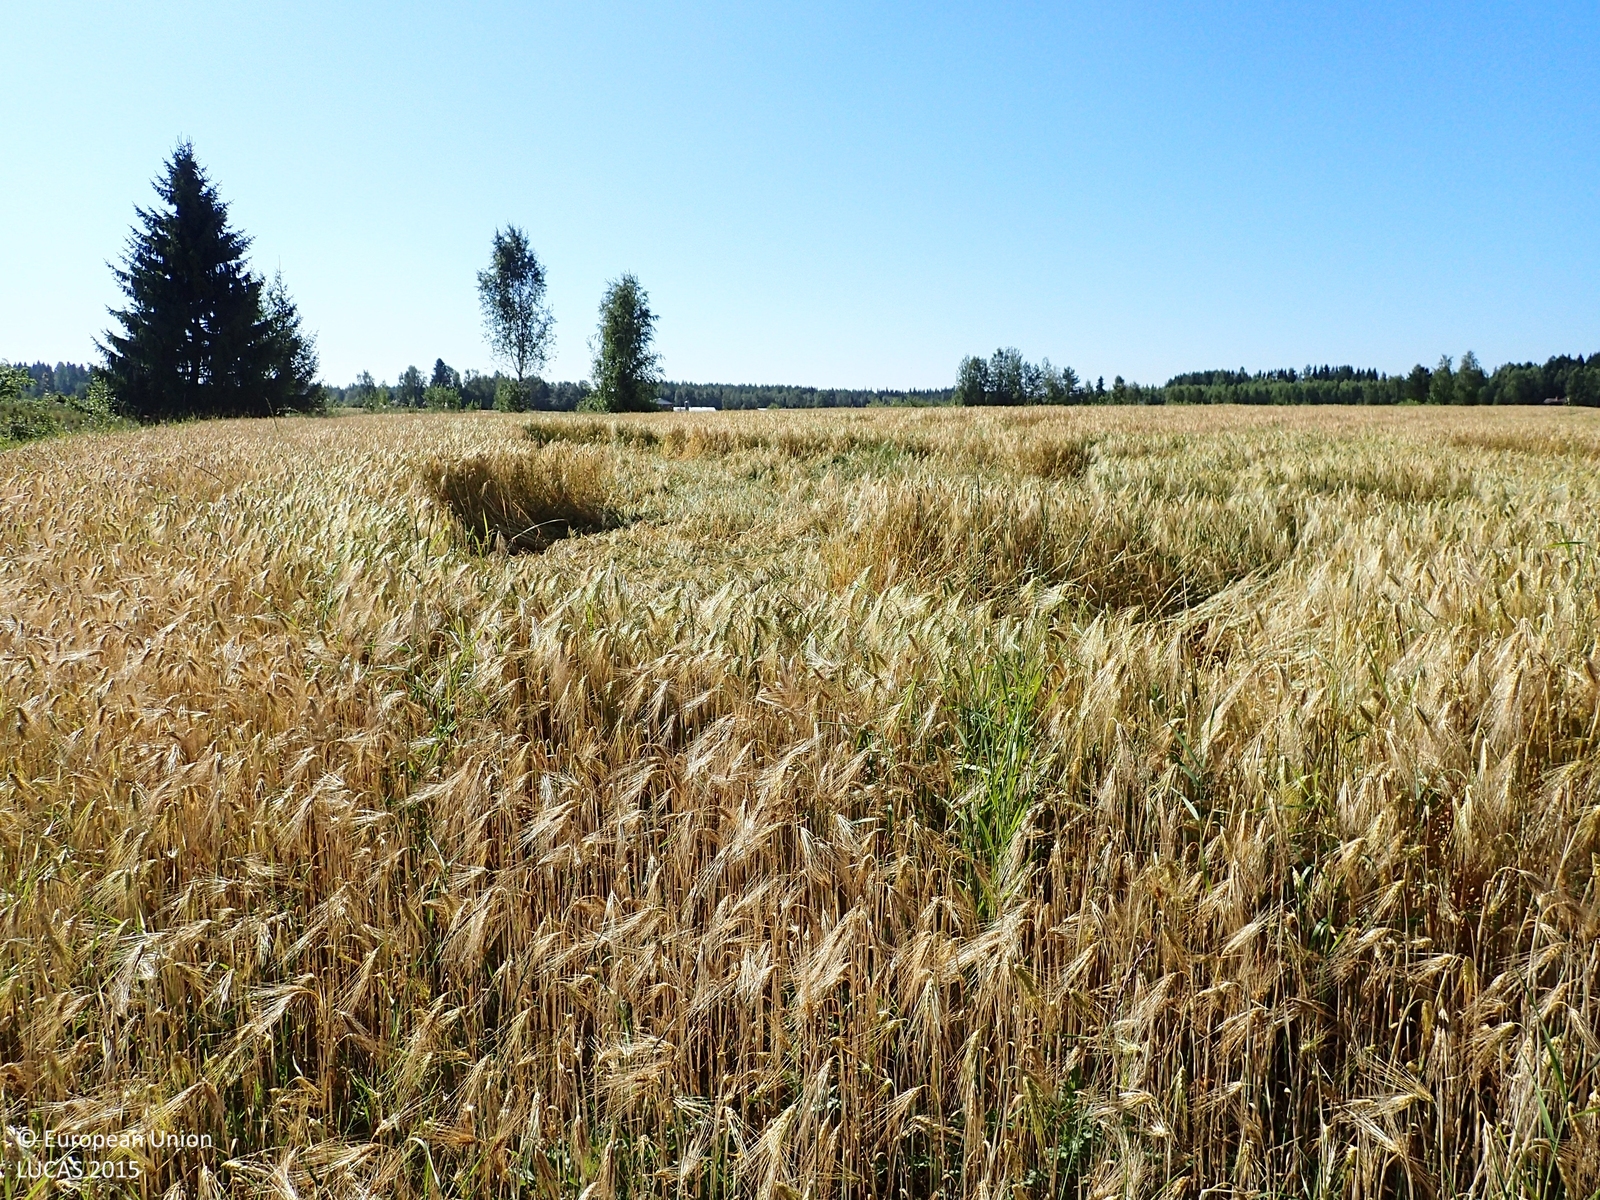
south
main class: Cropland
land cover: Barley
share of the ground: > 75 %
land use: Agriculture (excluding fallow land and kitchen gardens)
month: August
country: FI
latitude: 62.5354
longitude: 22.6321
